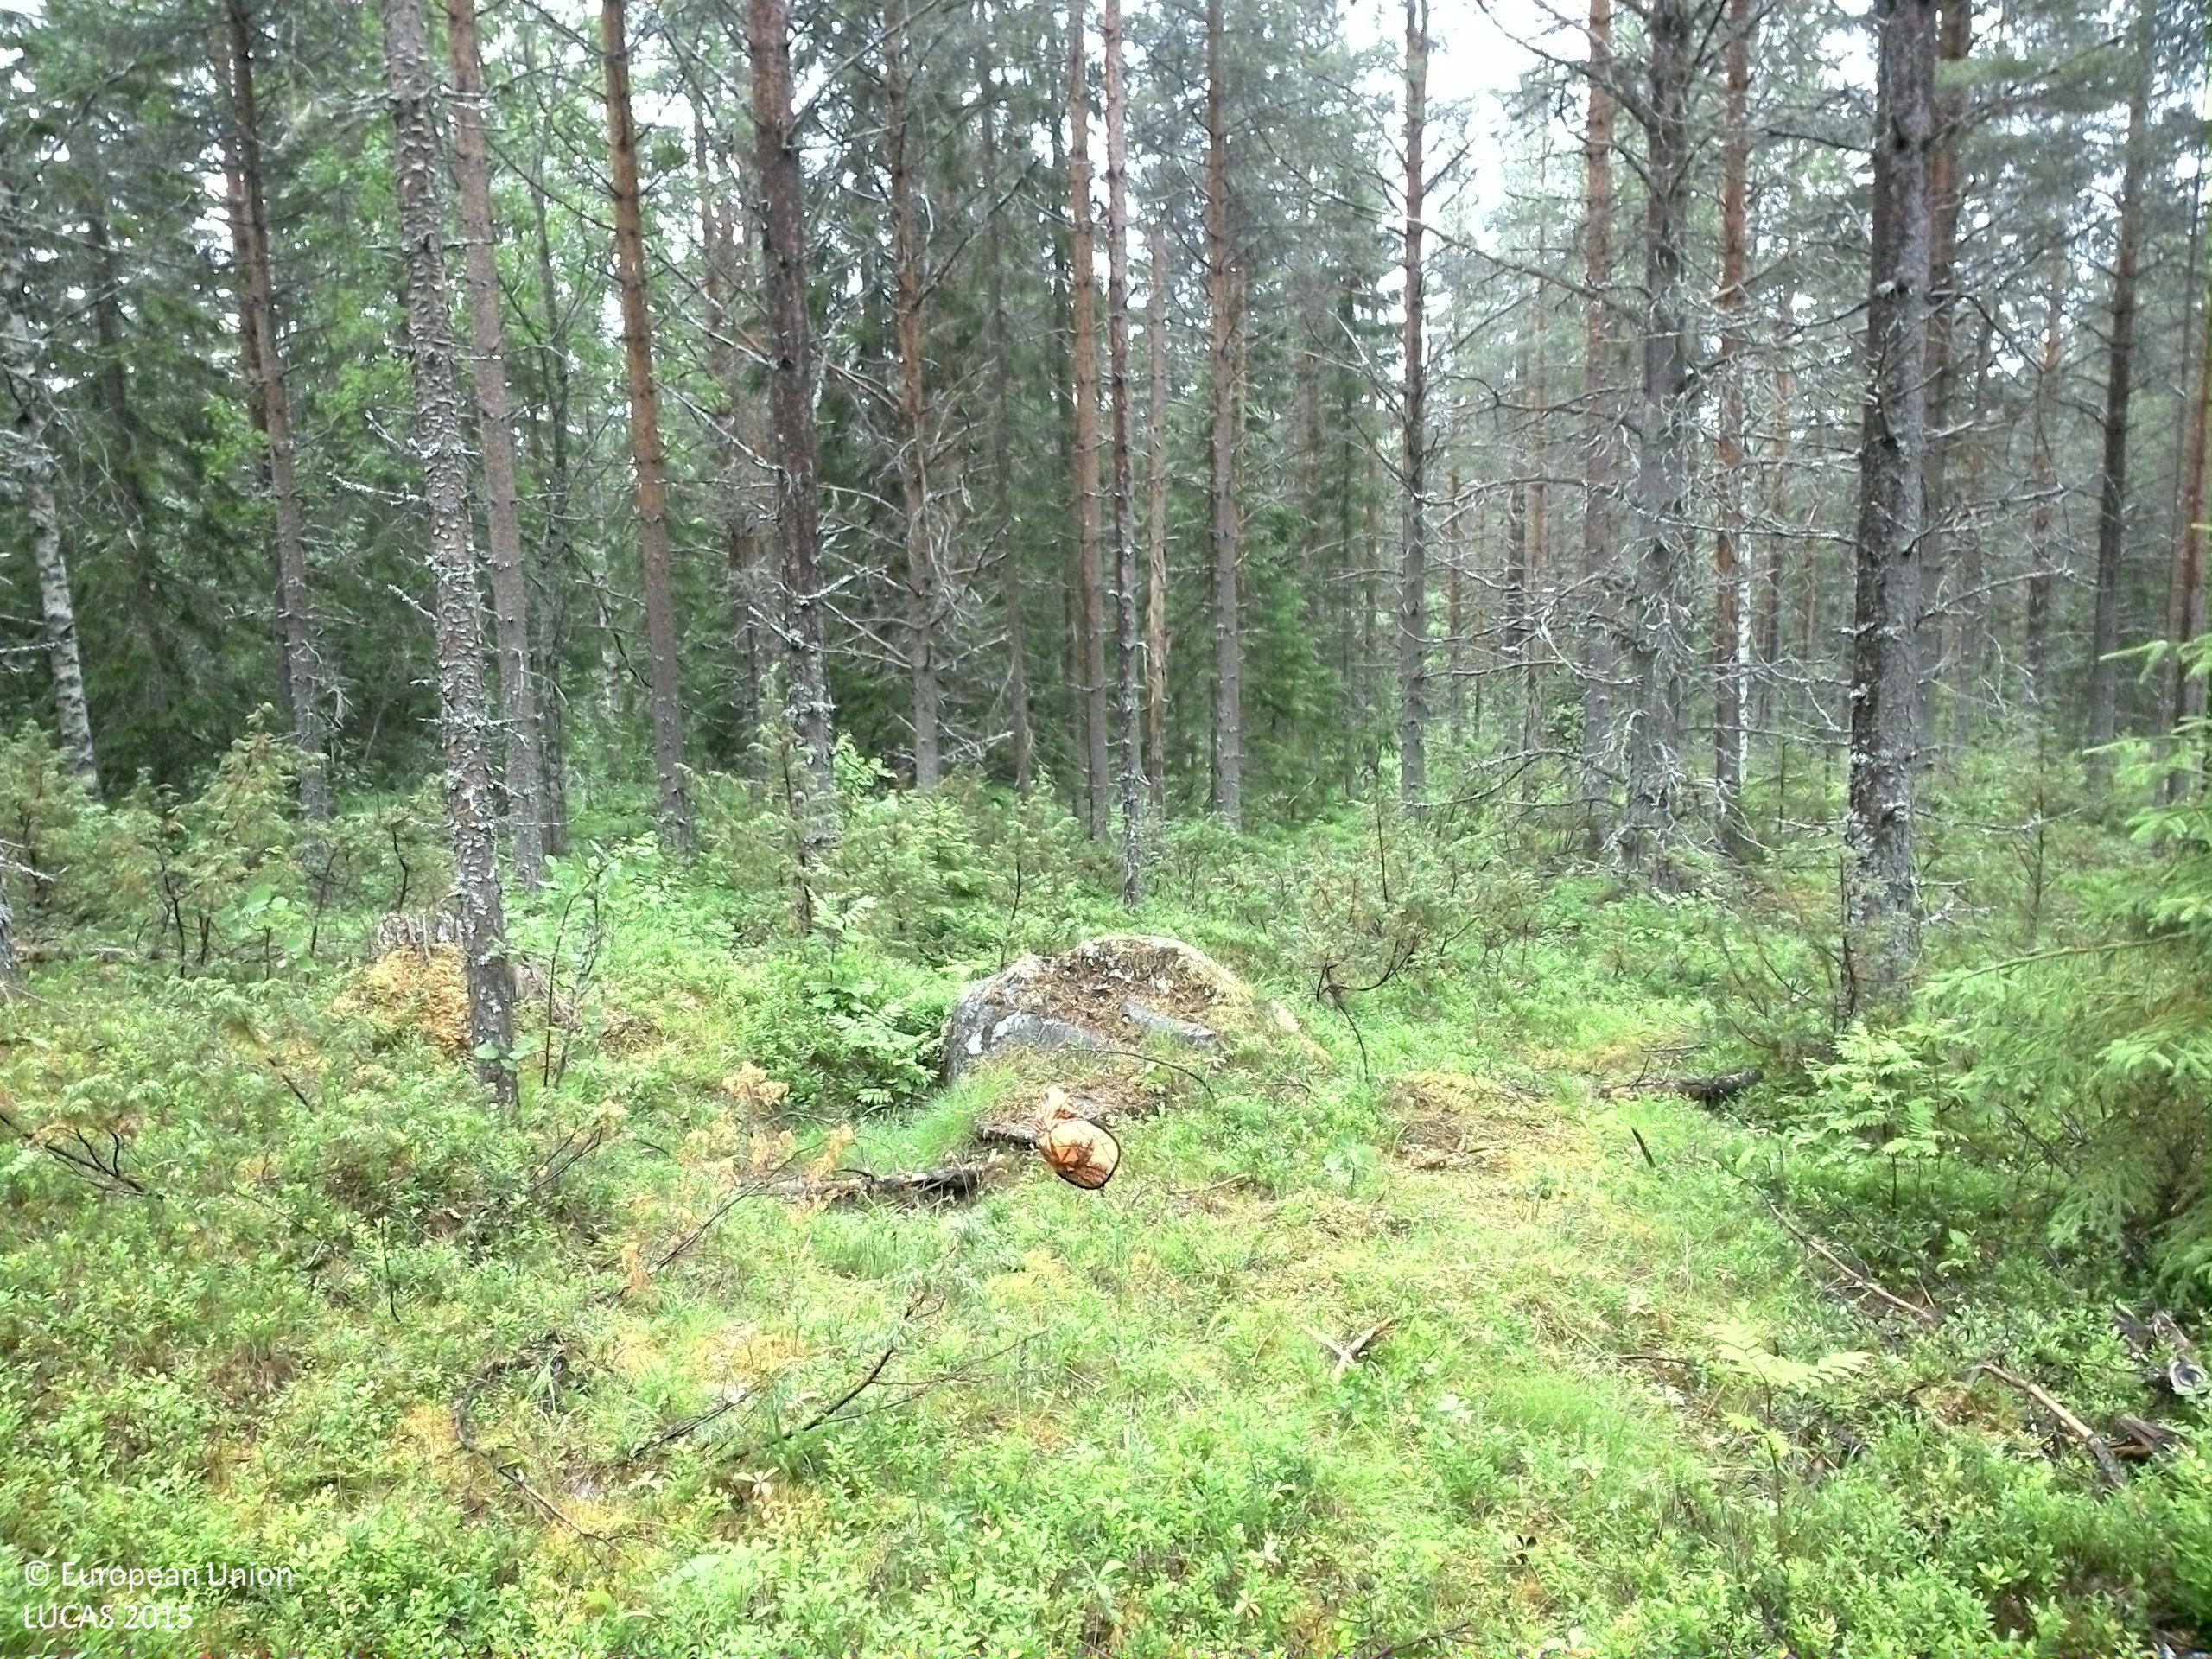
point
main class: Woodland
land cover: Pine dominated mixed woodland
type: boreal forest
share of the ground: 50 - 75 %
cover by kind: coniferous forest trees 40 %, broadleaved forest trees 20 %, shrubs 20 %, herbaceous plants 10 %, lichens and mosses 10 %
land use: Forestry
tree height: > 5 m
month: July
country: SE
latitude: 63.6854
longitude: 17.3121
